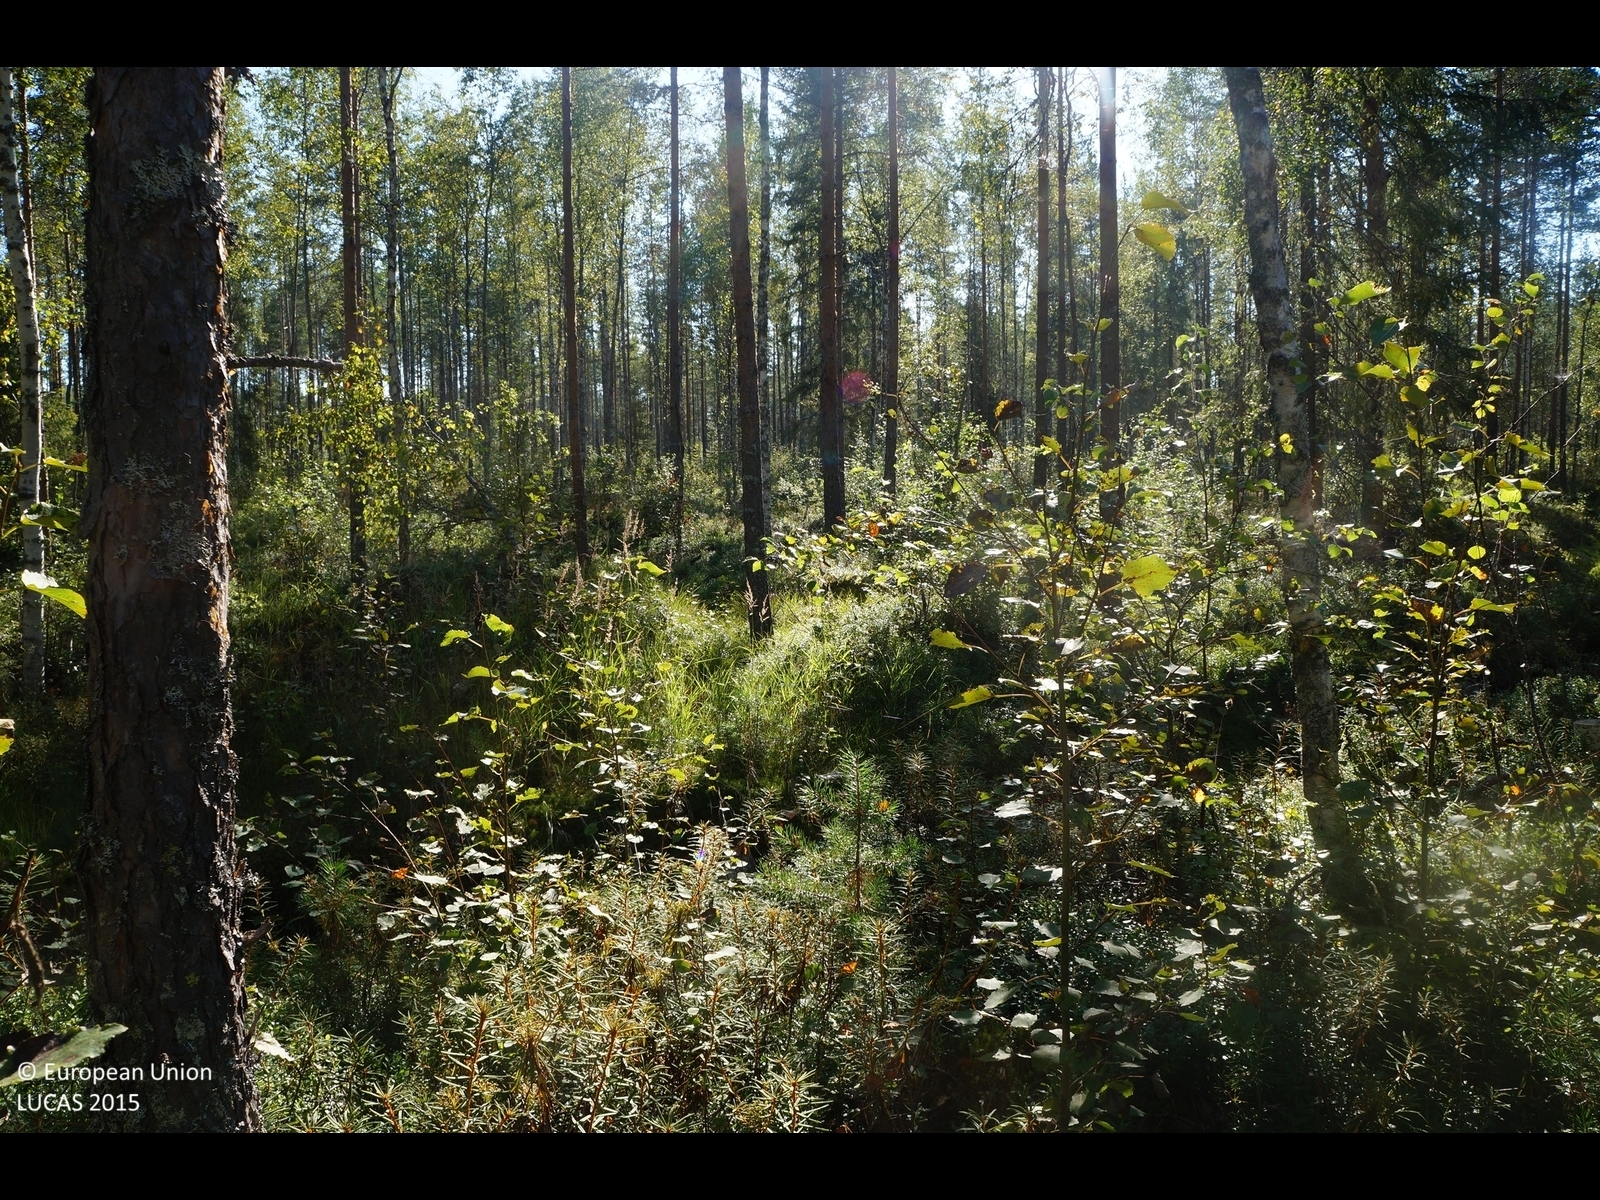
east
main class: Woodland
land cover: Pine dominated mixed woodland
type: boreal forest
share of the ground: 50 - 75 %
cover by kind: shrubs 30 %, coniferous forest trees 25 %, broadleaved forest trees 25 %, herbaceous plants 10 %, lichens and mosses 10 %
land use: Forestry
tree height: > 5 m
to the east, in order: Pine dominated mixed woodland; Ditches and canals; Pine dominated mixed woodland; Broadleaved woodland; Pine dominated mixed woodland; Ditches and canals; Shruby margins; Paved roads, cycling and walking lanes; Shruby margins; Ditches and canals; Shrubland with sparse tree cover; Tracks; Shrubland with sparse tree cover; Ditches and canals; Pine dominated mixed woodland
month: August
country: FI
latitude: 64.2850
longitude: 25.2276
